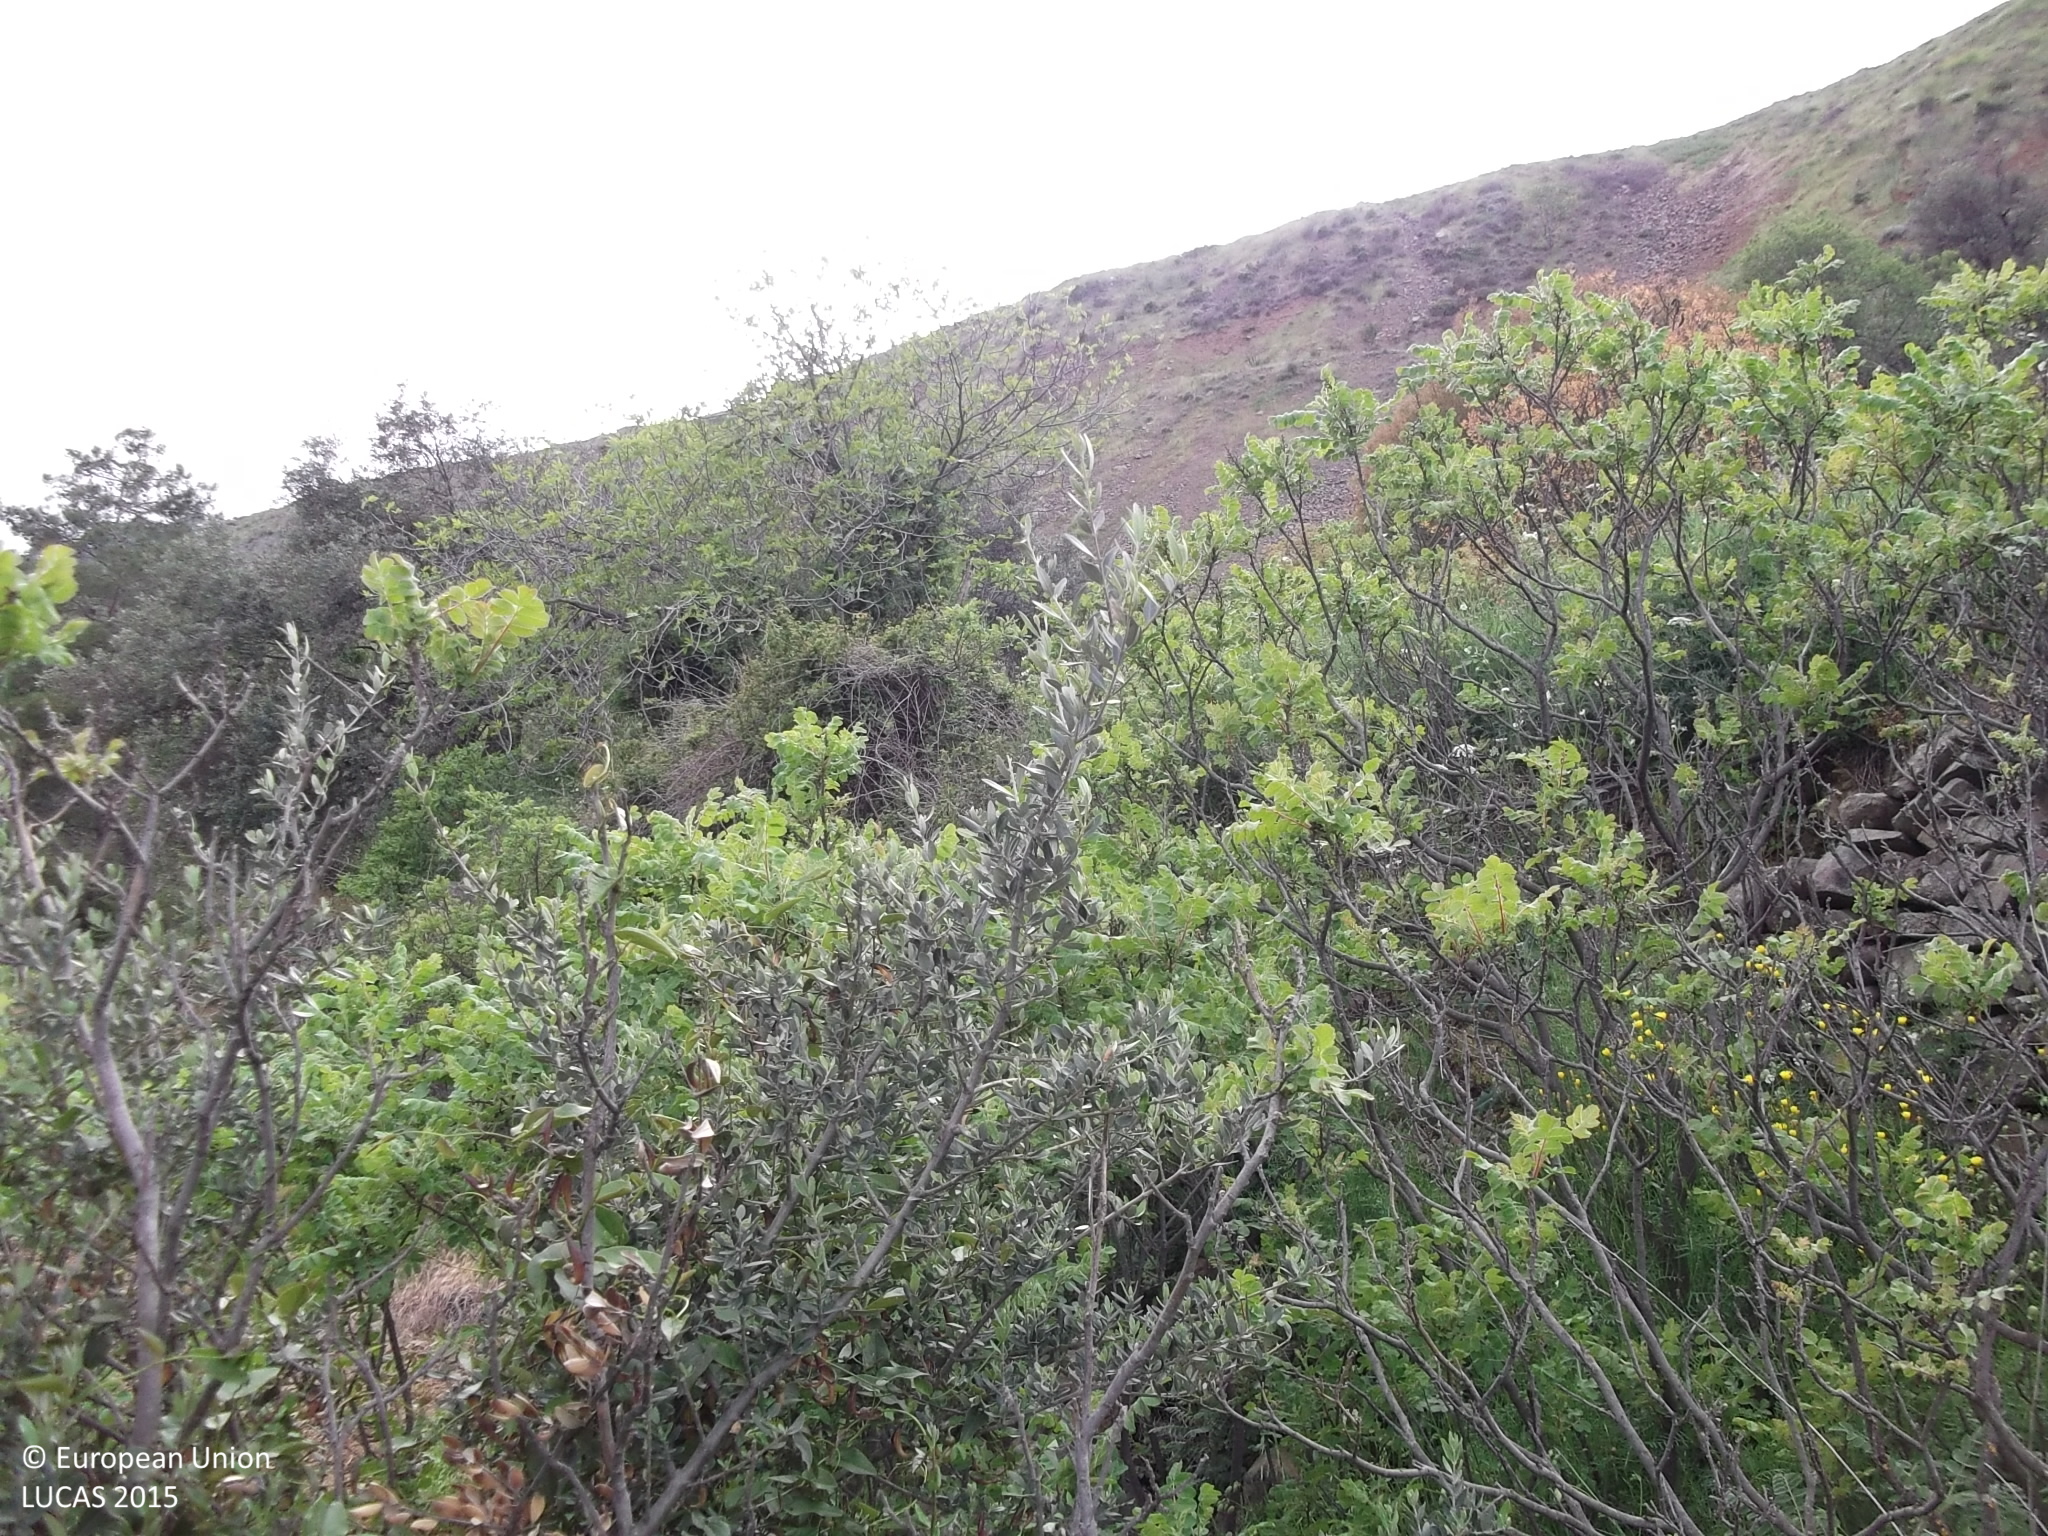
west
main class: Woodland
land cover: Pine dominated coniferous woodland
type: coniferous forest of the mediterranean region
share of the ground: 10 - 25 %
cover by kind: shrubs 65 %, unconsolidated bare surface 20 %, coniferous forest trees 15 %
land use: Semi-natural and natural areas not in use
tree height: > 5 m
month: April
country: CY
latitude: 34.9460
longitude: 33.1387
